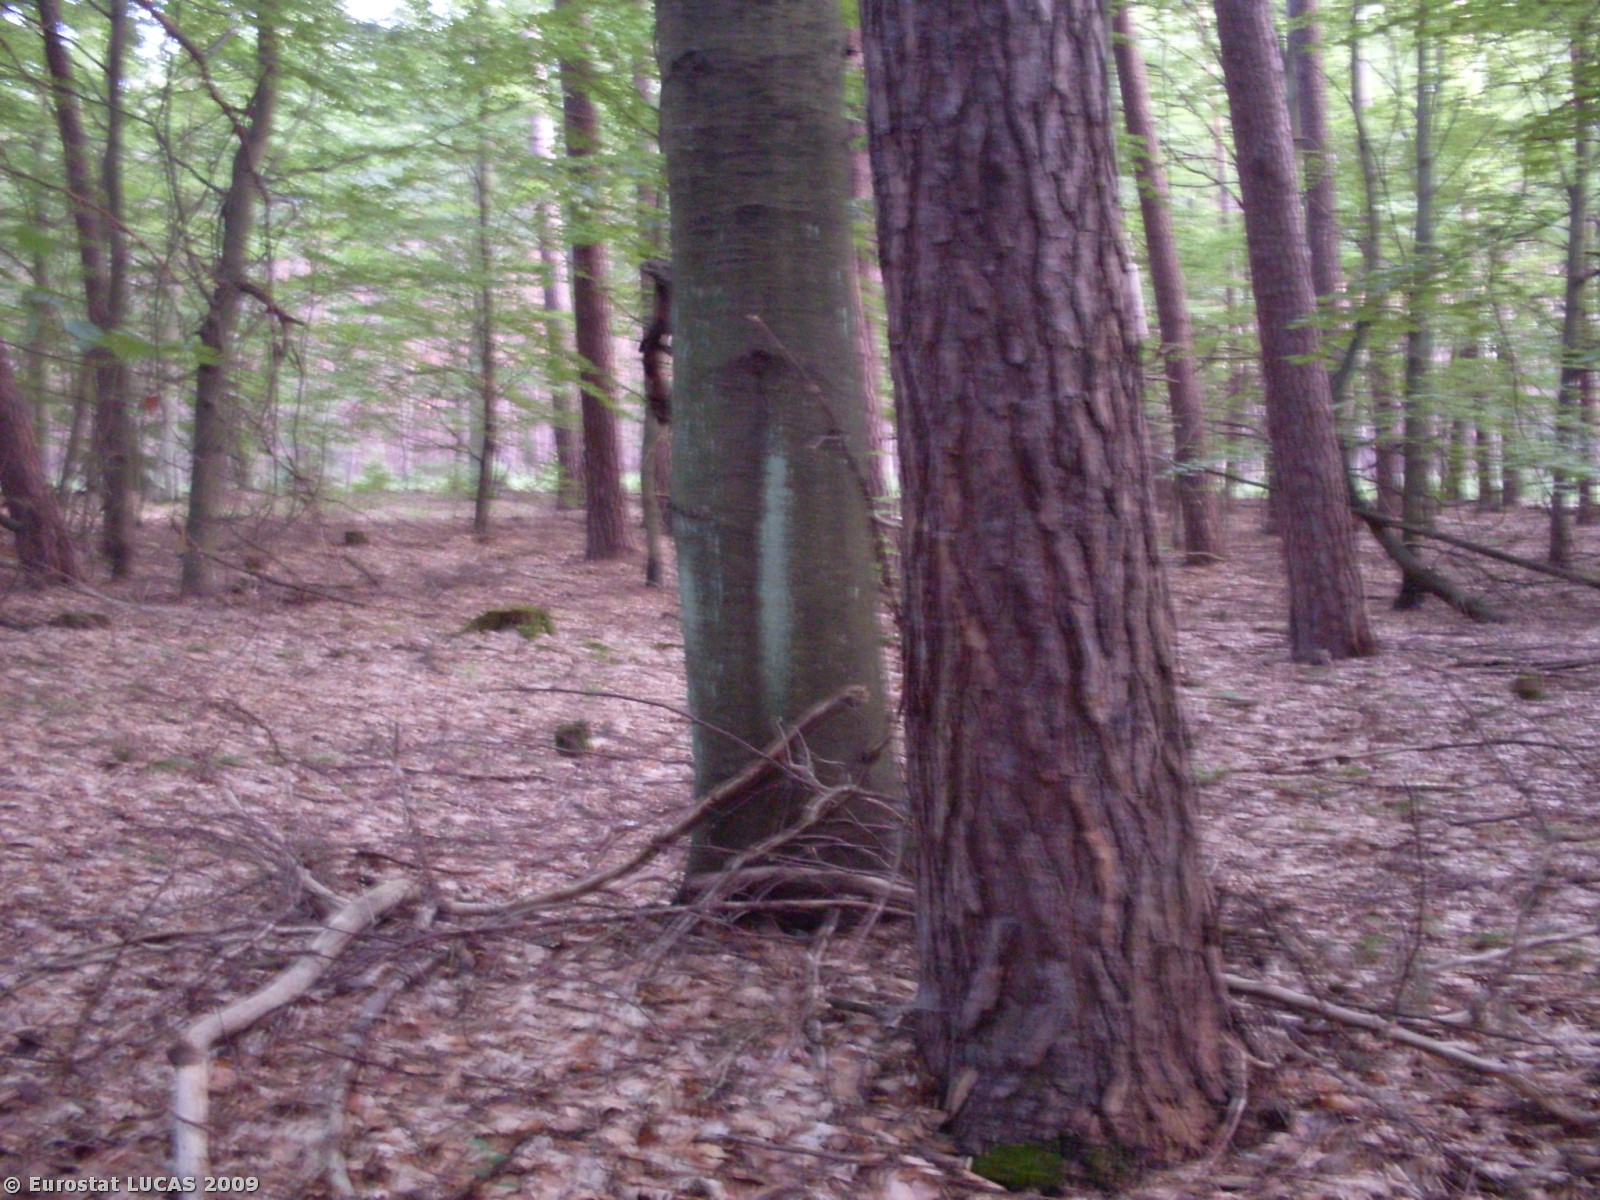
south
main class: Woodland
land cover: Mixed woodland
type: hemiboreal forest and nemoral coniferous forest and mixed broadleaved-coniferous forest
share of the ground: > 75 %
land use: Forestry
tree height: > 5 m
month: August
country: PL
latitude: 53.0406
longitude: 15.9261
